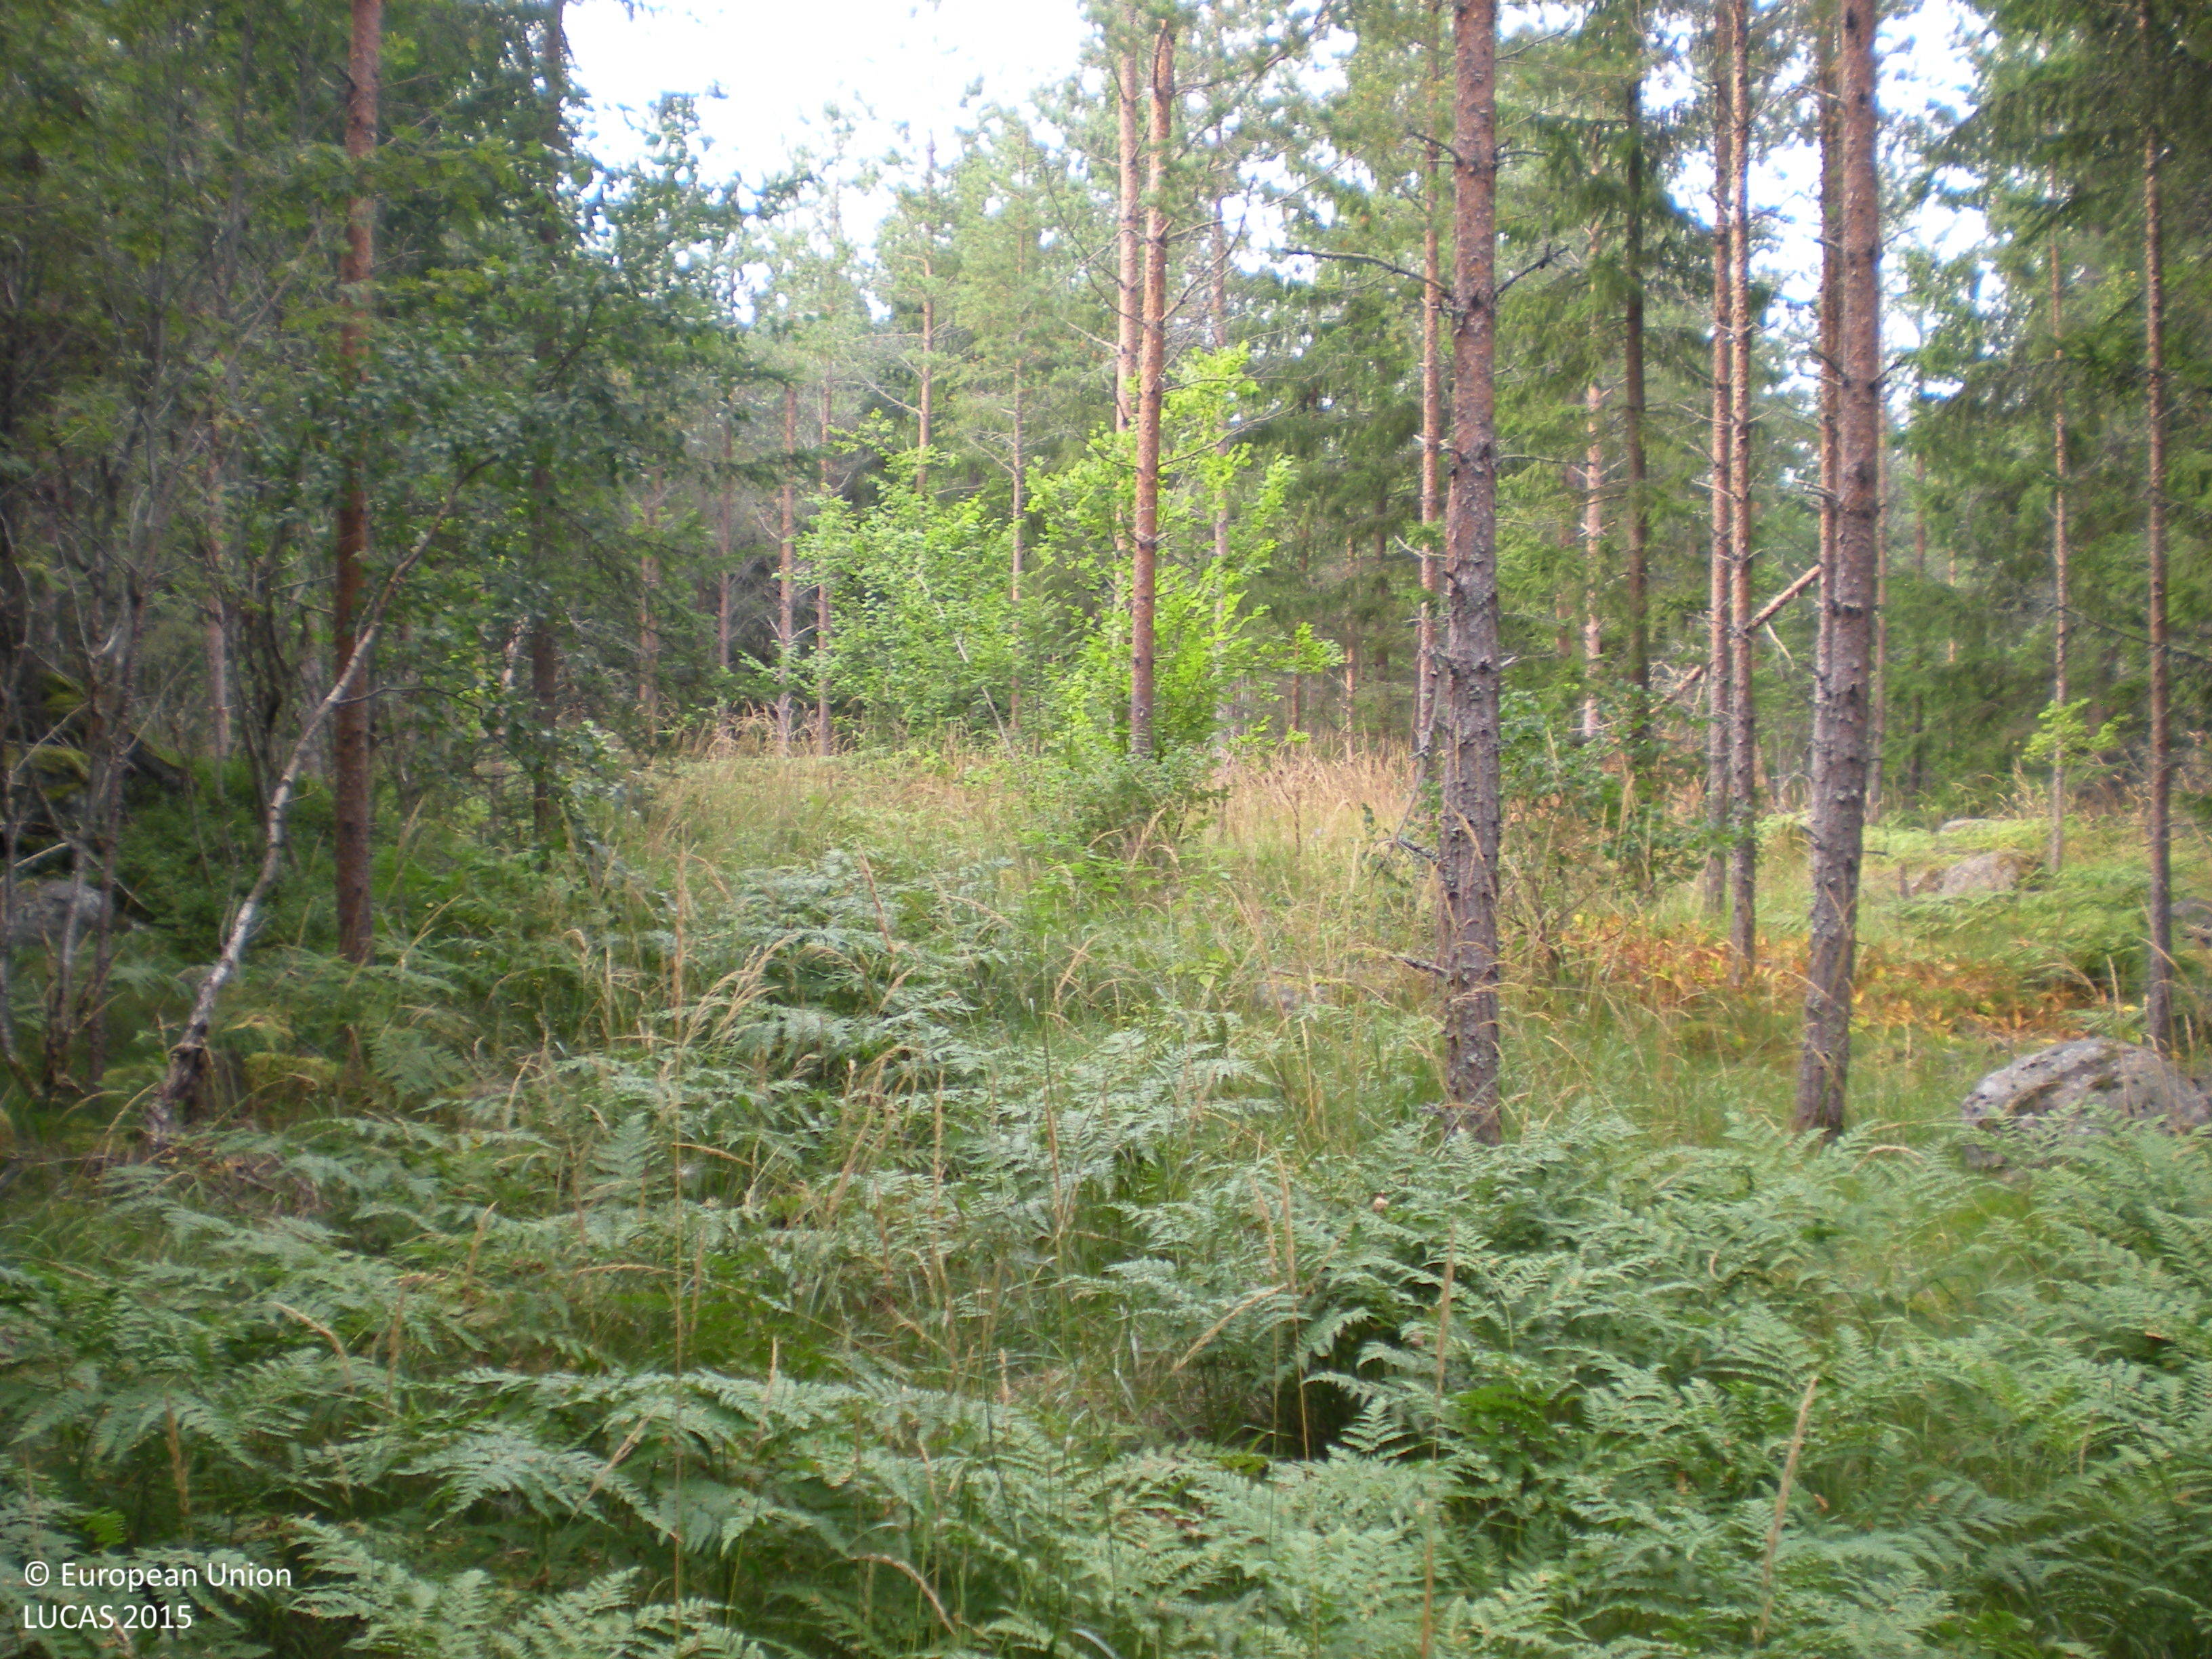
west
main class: Woodland
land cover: Other coniferous woodland
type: boreal forest
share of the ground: 50 - 75 %
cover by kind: coniferous forest trees 65 %, herbaceous plants 20 %, broadleaved forest trees 5 %, shrubs 5 %, lichens and mosses 5 %
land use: Forestry
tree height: > 5 m
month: August
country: SE
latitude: 60.4637
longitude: 17.6110
